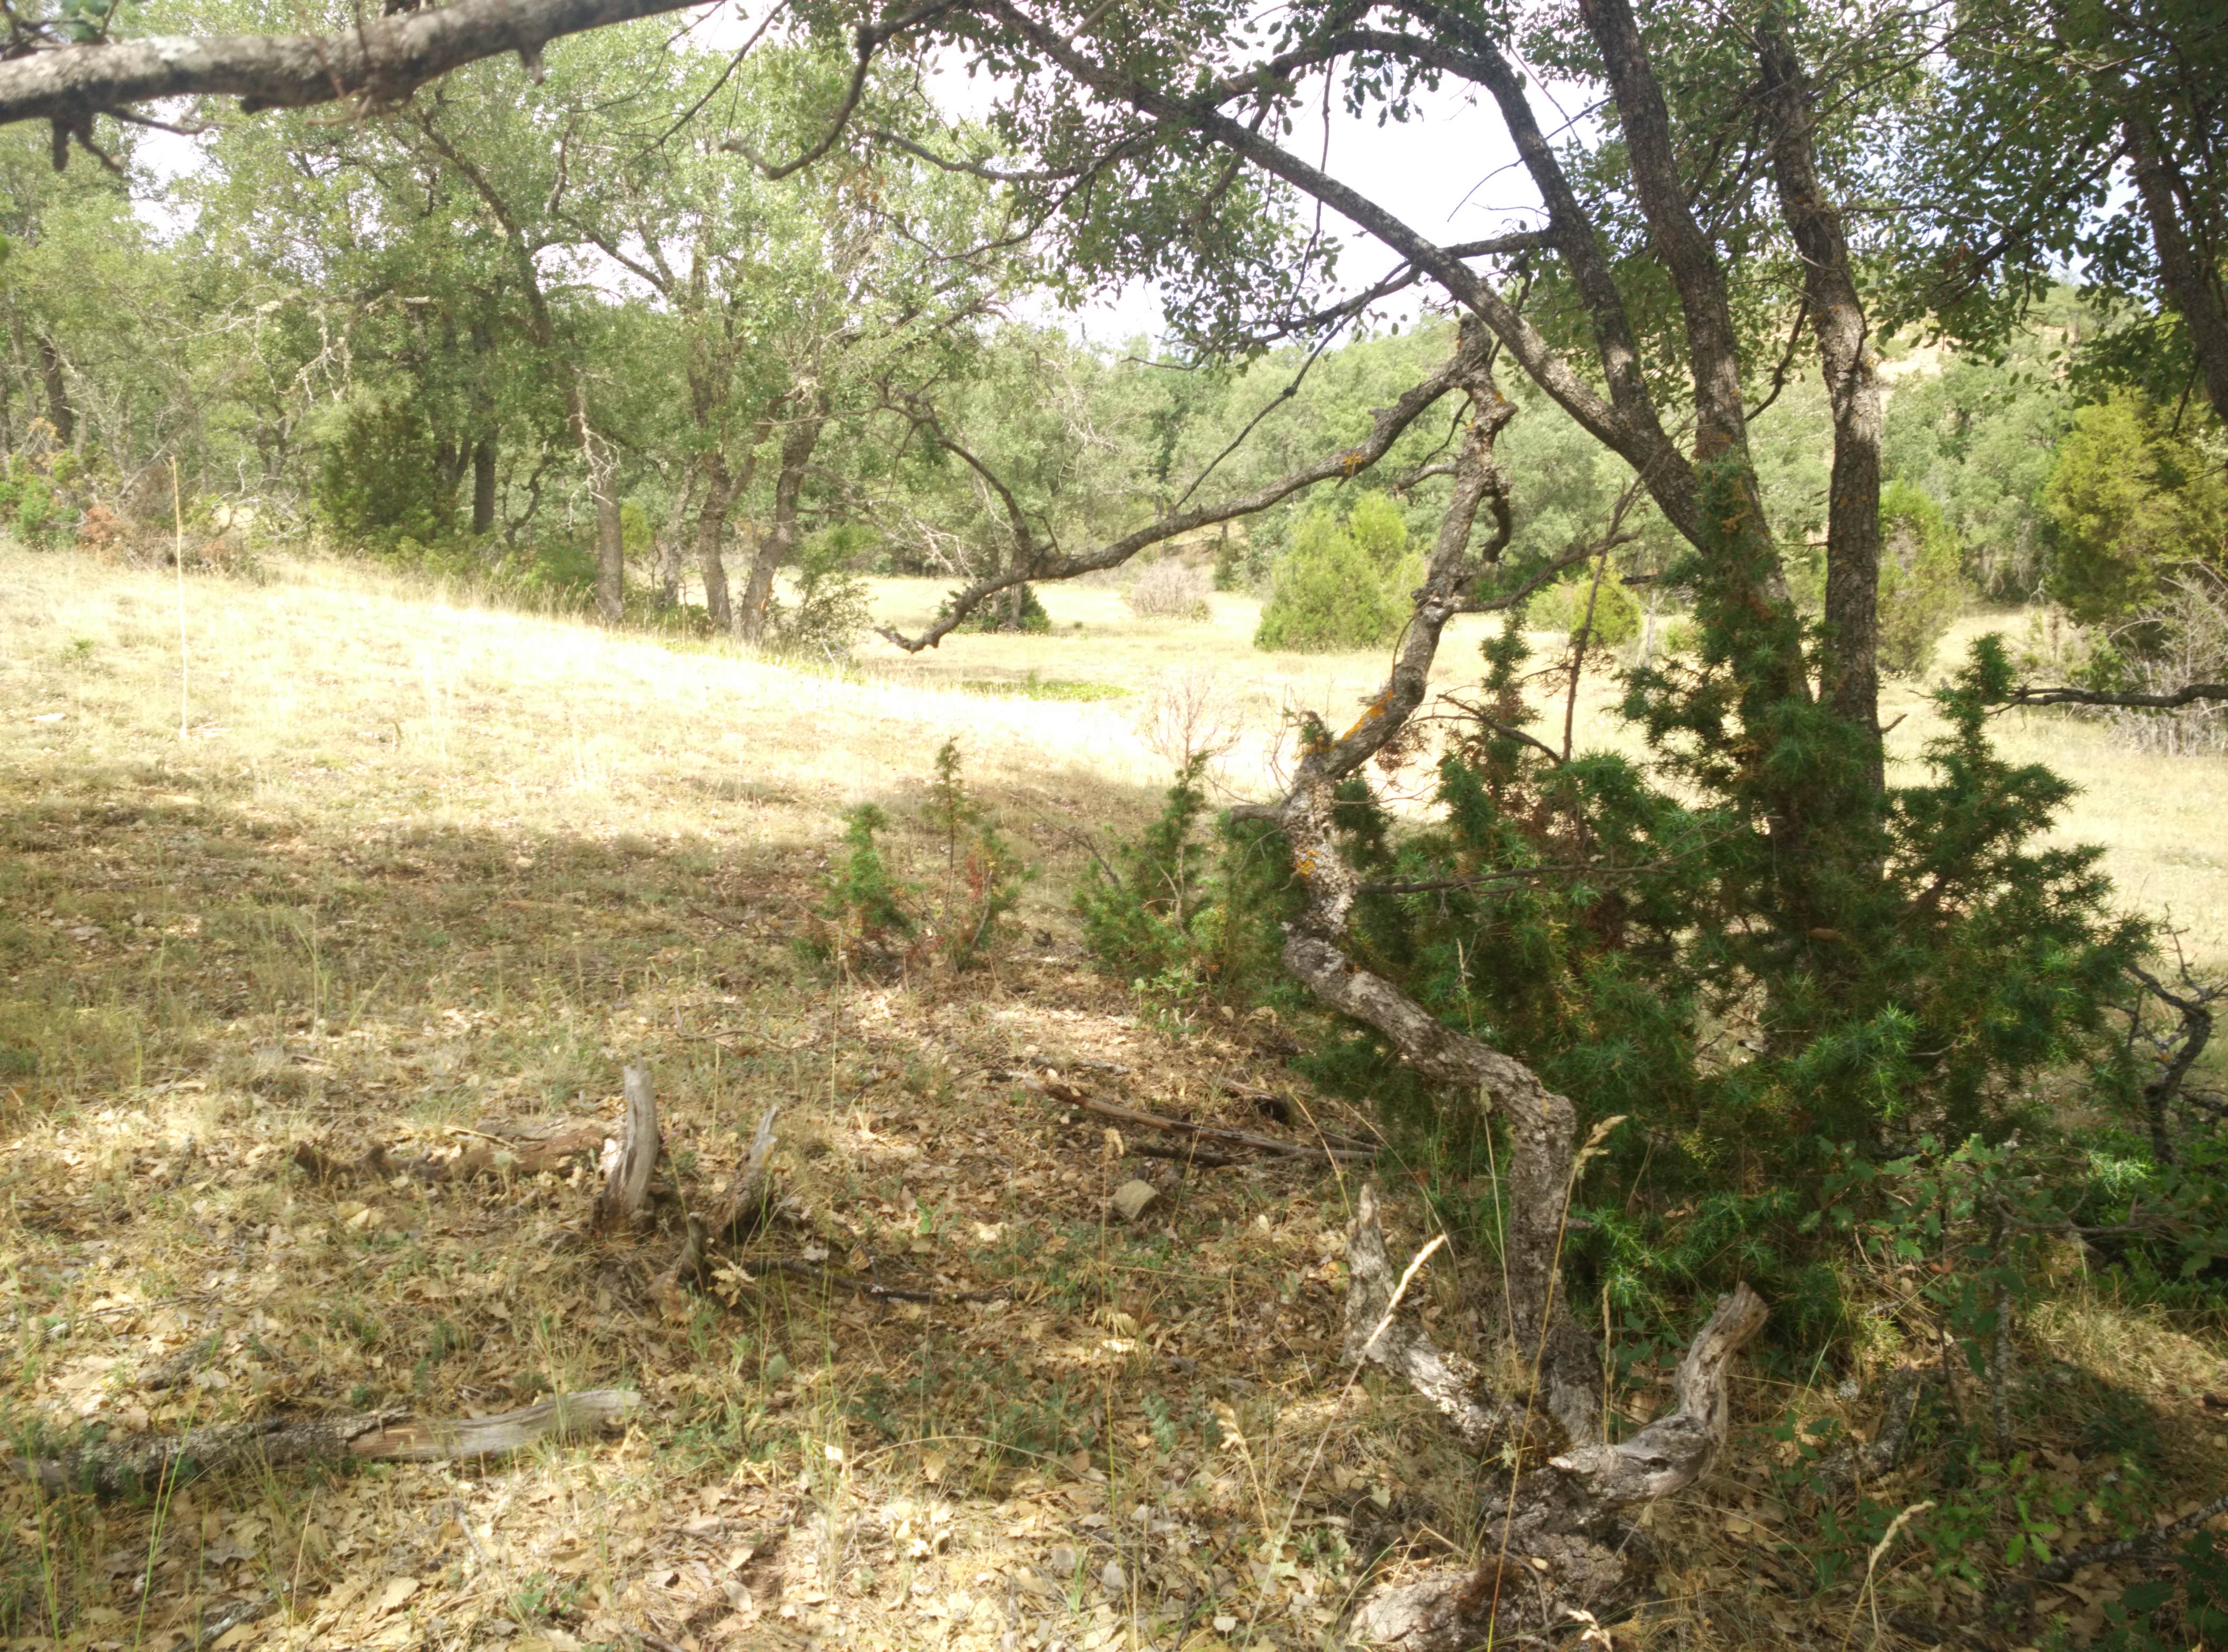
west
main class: Grassland
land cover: Grassland with sparse tree/shrub cover
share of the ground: 50 - 75 %
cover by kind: herbaceous plants 60 %, unconsolidated bare surface 30 %, broadleaved forest trees 5 %, shrubs 5 %
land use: Semi-natural and natural areas not in use
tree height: > 5 m
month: July
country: ES
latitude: 40.9362
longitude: -1.9843
